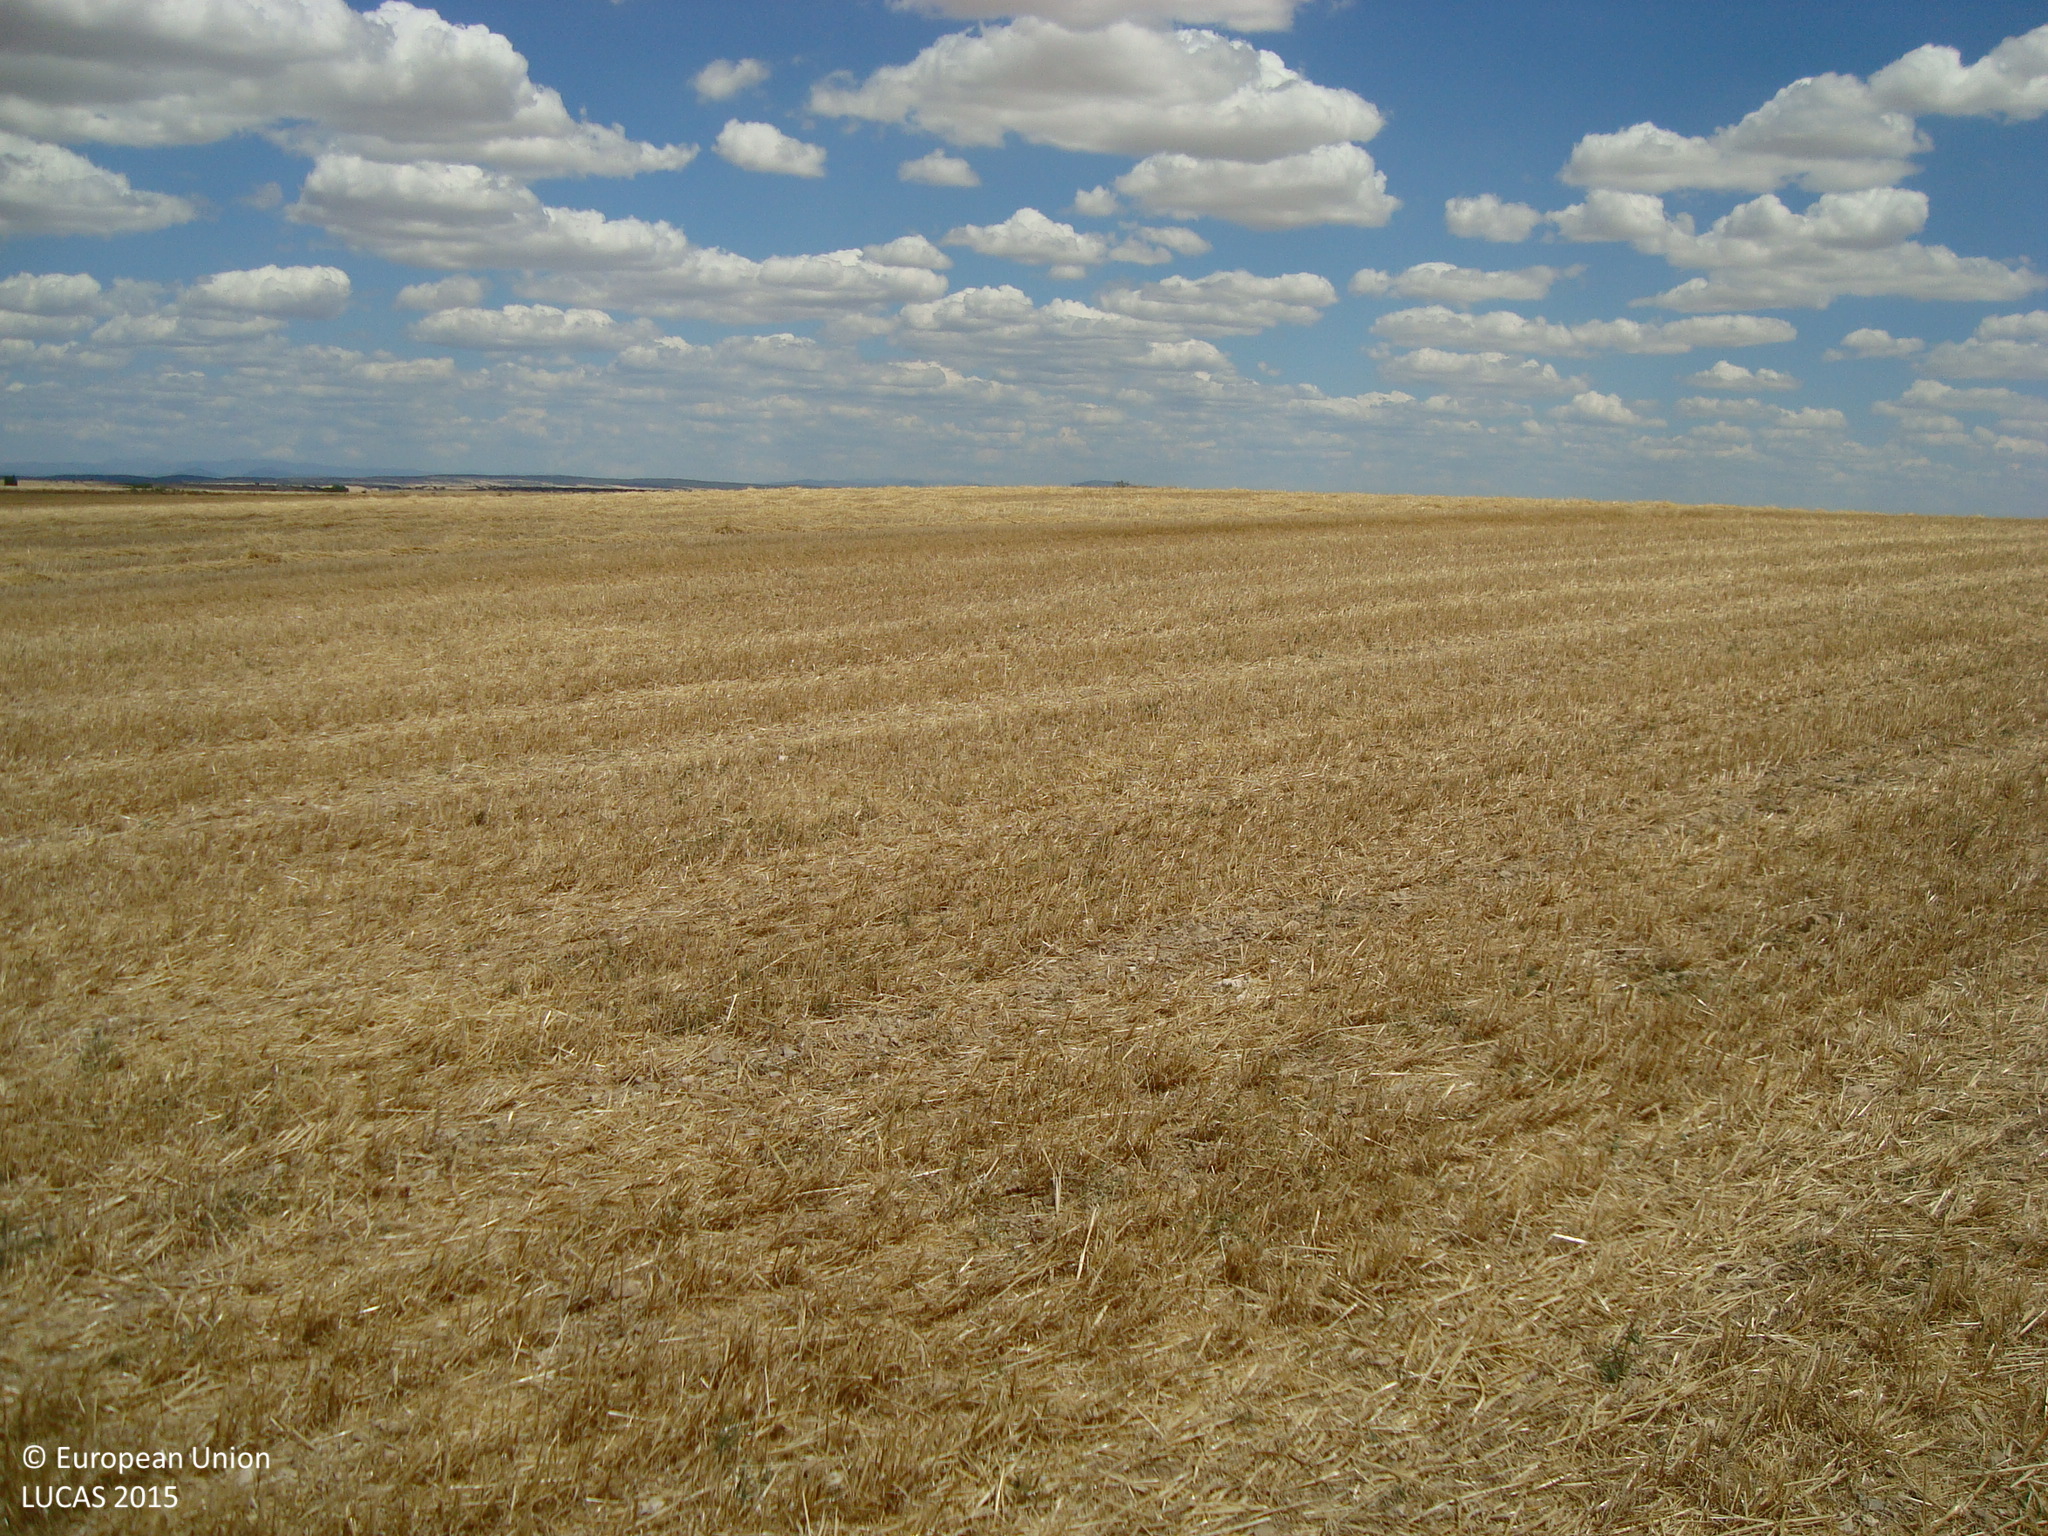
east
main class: Cropland
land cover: Barley
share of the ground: > 75 %
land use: Agriculture (excluding fallow land and kitchen gardens)
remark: Harvested field
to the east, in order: Barley; Tracks; Dry pulses
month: July
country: ES
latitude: 41.9085
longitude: -3.9107
